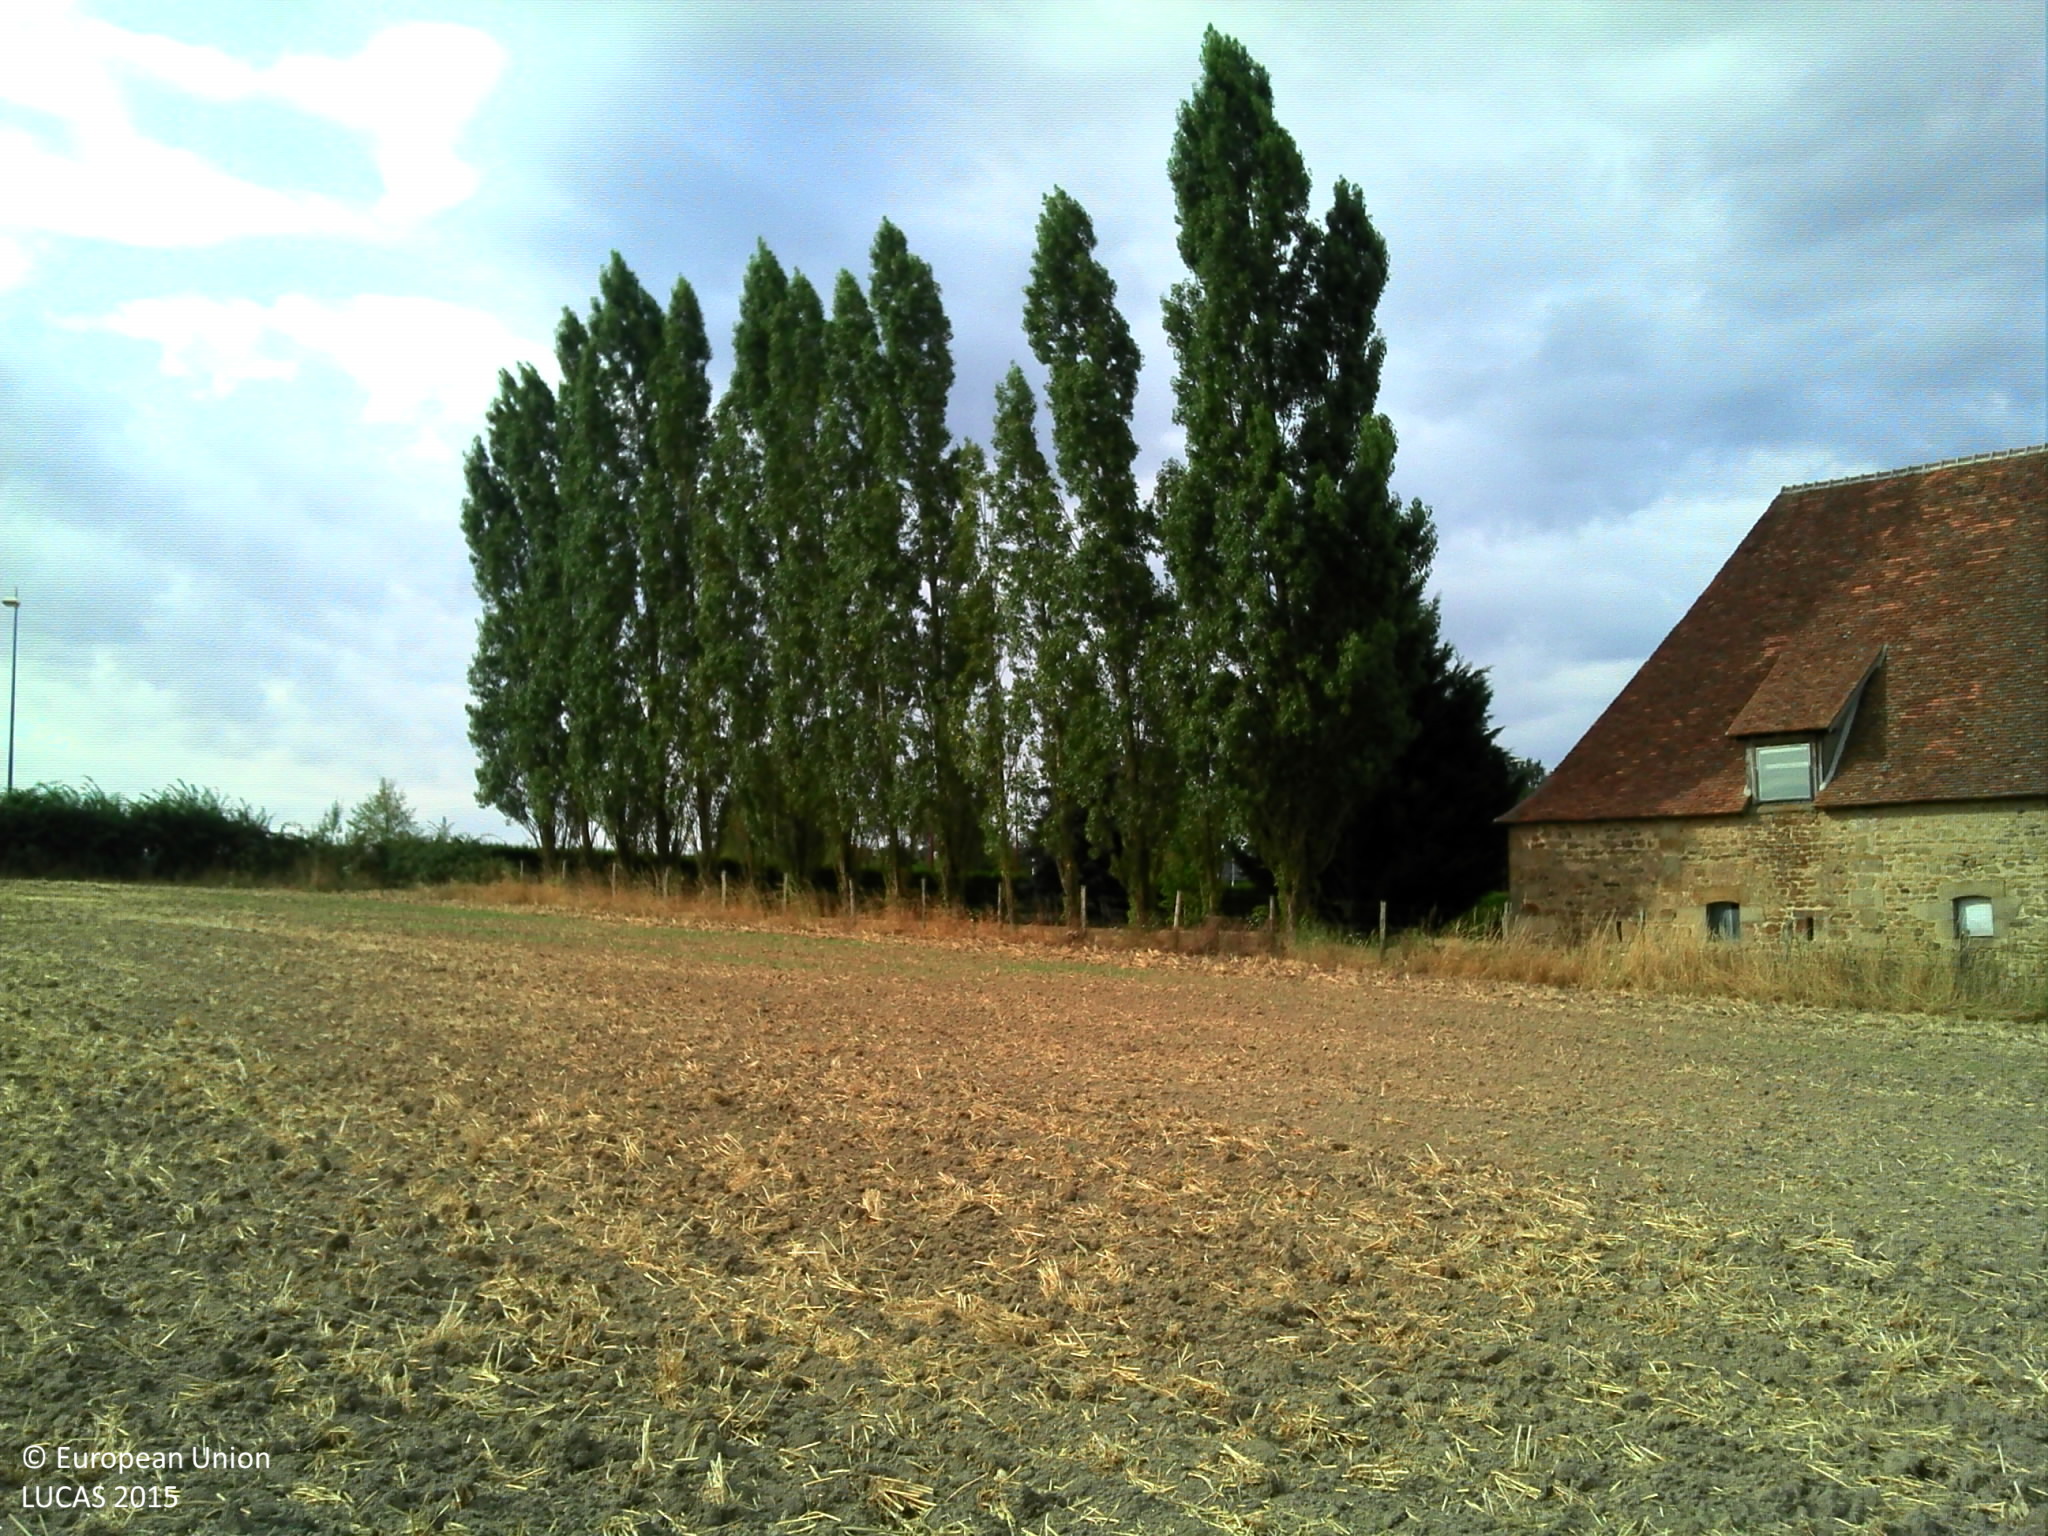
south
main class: Cropland
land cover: Barley
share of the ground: 10 - 25 %
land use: Agriculture (excluding fallow land and kitchen gardens)
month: July
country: FR
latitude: 46.5764
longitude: 3.0422
